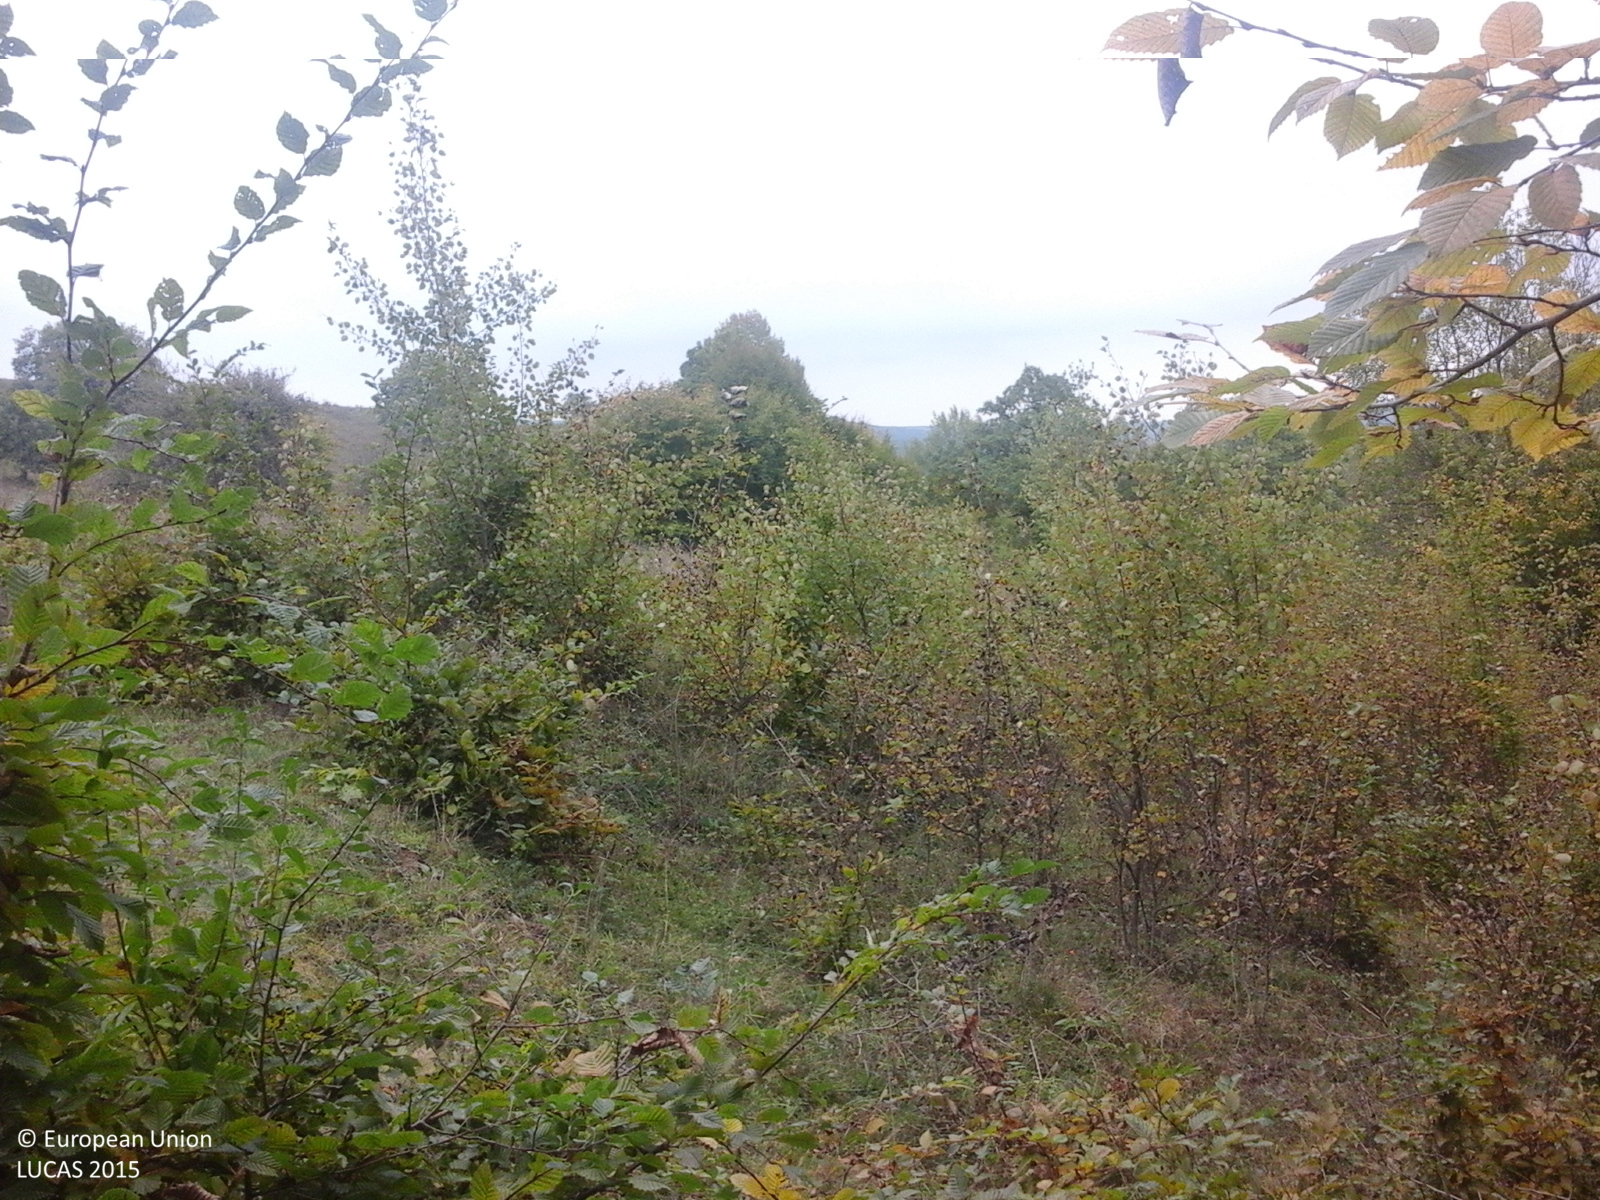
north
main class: Woodland
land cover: Broadleaved woodland
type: beech forest
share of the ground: > 75 %
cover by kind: broadleaved forest trees 100 %
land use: Forestry
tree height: > 5 m
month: October
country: RO
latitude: 45.9522
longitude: 25.2053
